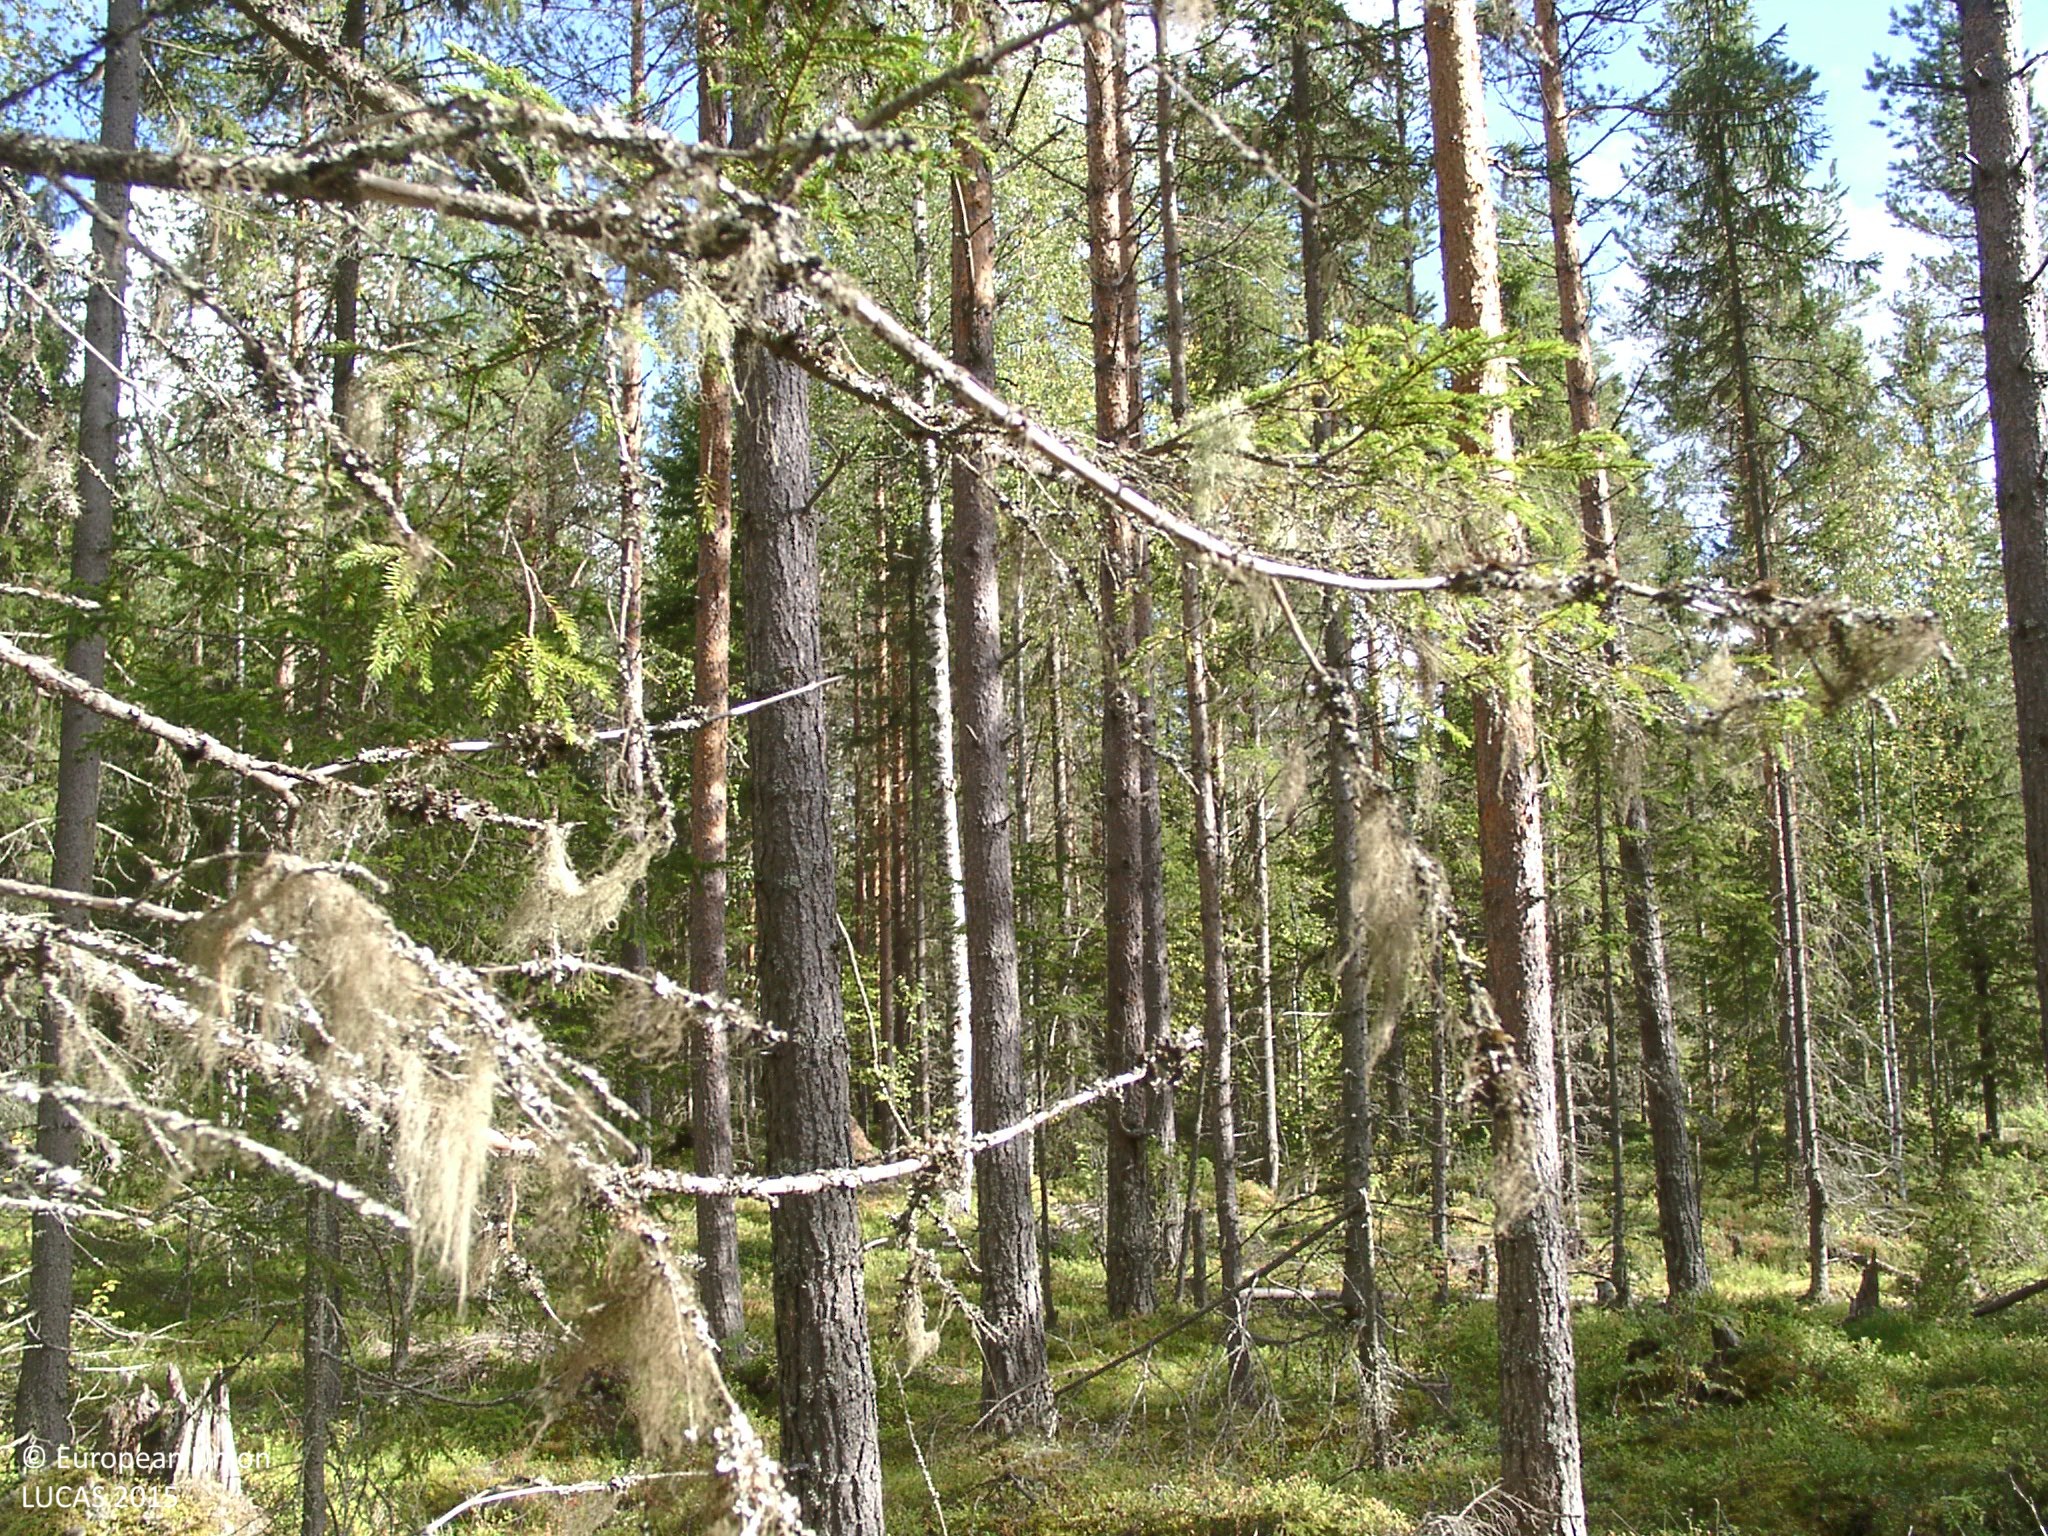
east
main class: Woodland
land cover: Other mixed woodland
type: boreal forest
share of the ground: 50 - 75 %
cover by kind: coniferous forest trees 40 %, shrubs 25 %, broadleaved forest trees 20 %, lichens and mosses 15 %
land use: Forestry
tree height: > 5 m
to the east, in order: Other mixed woodland; Other coniferous woodland; Pine dominated coniferous woodland; Pine dominated mixed woodland; Other mixed woodland; Ditches and canals; Managed hedges; Tracks; Managed hedges; Ditches and canals; Other mixed woodland
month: September
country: FI
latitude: 62.8741
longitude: 25.6622
